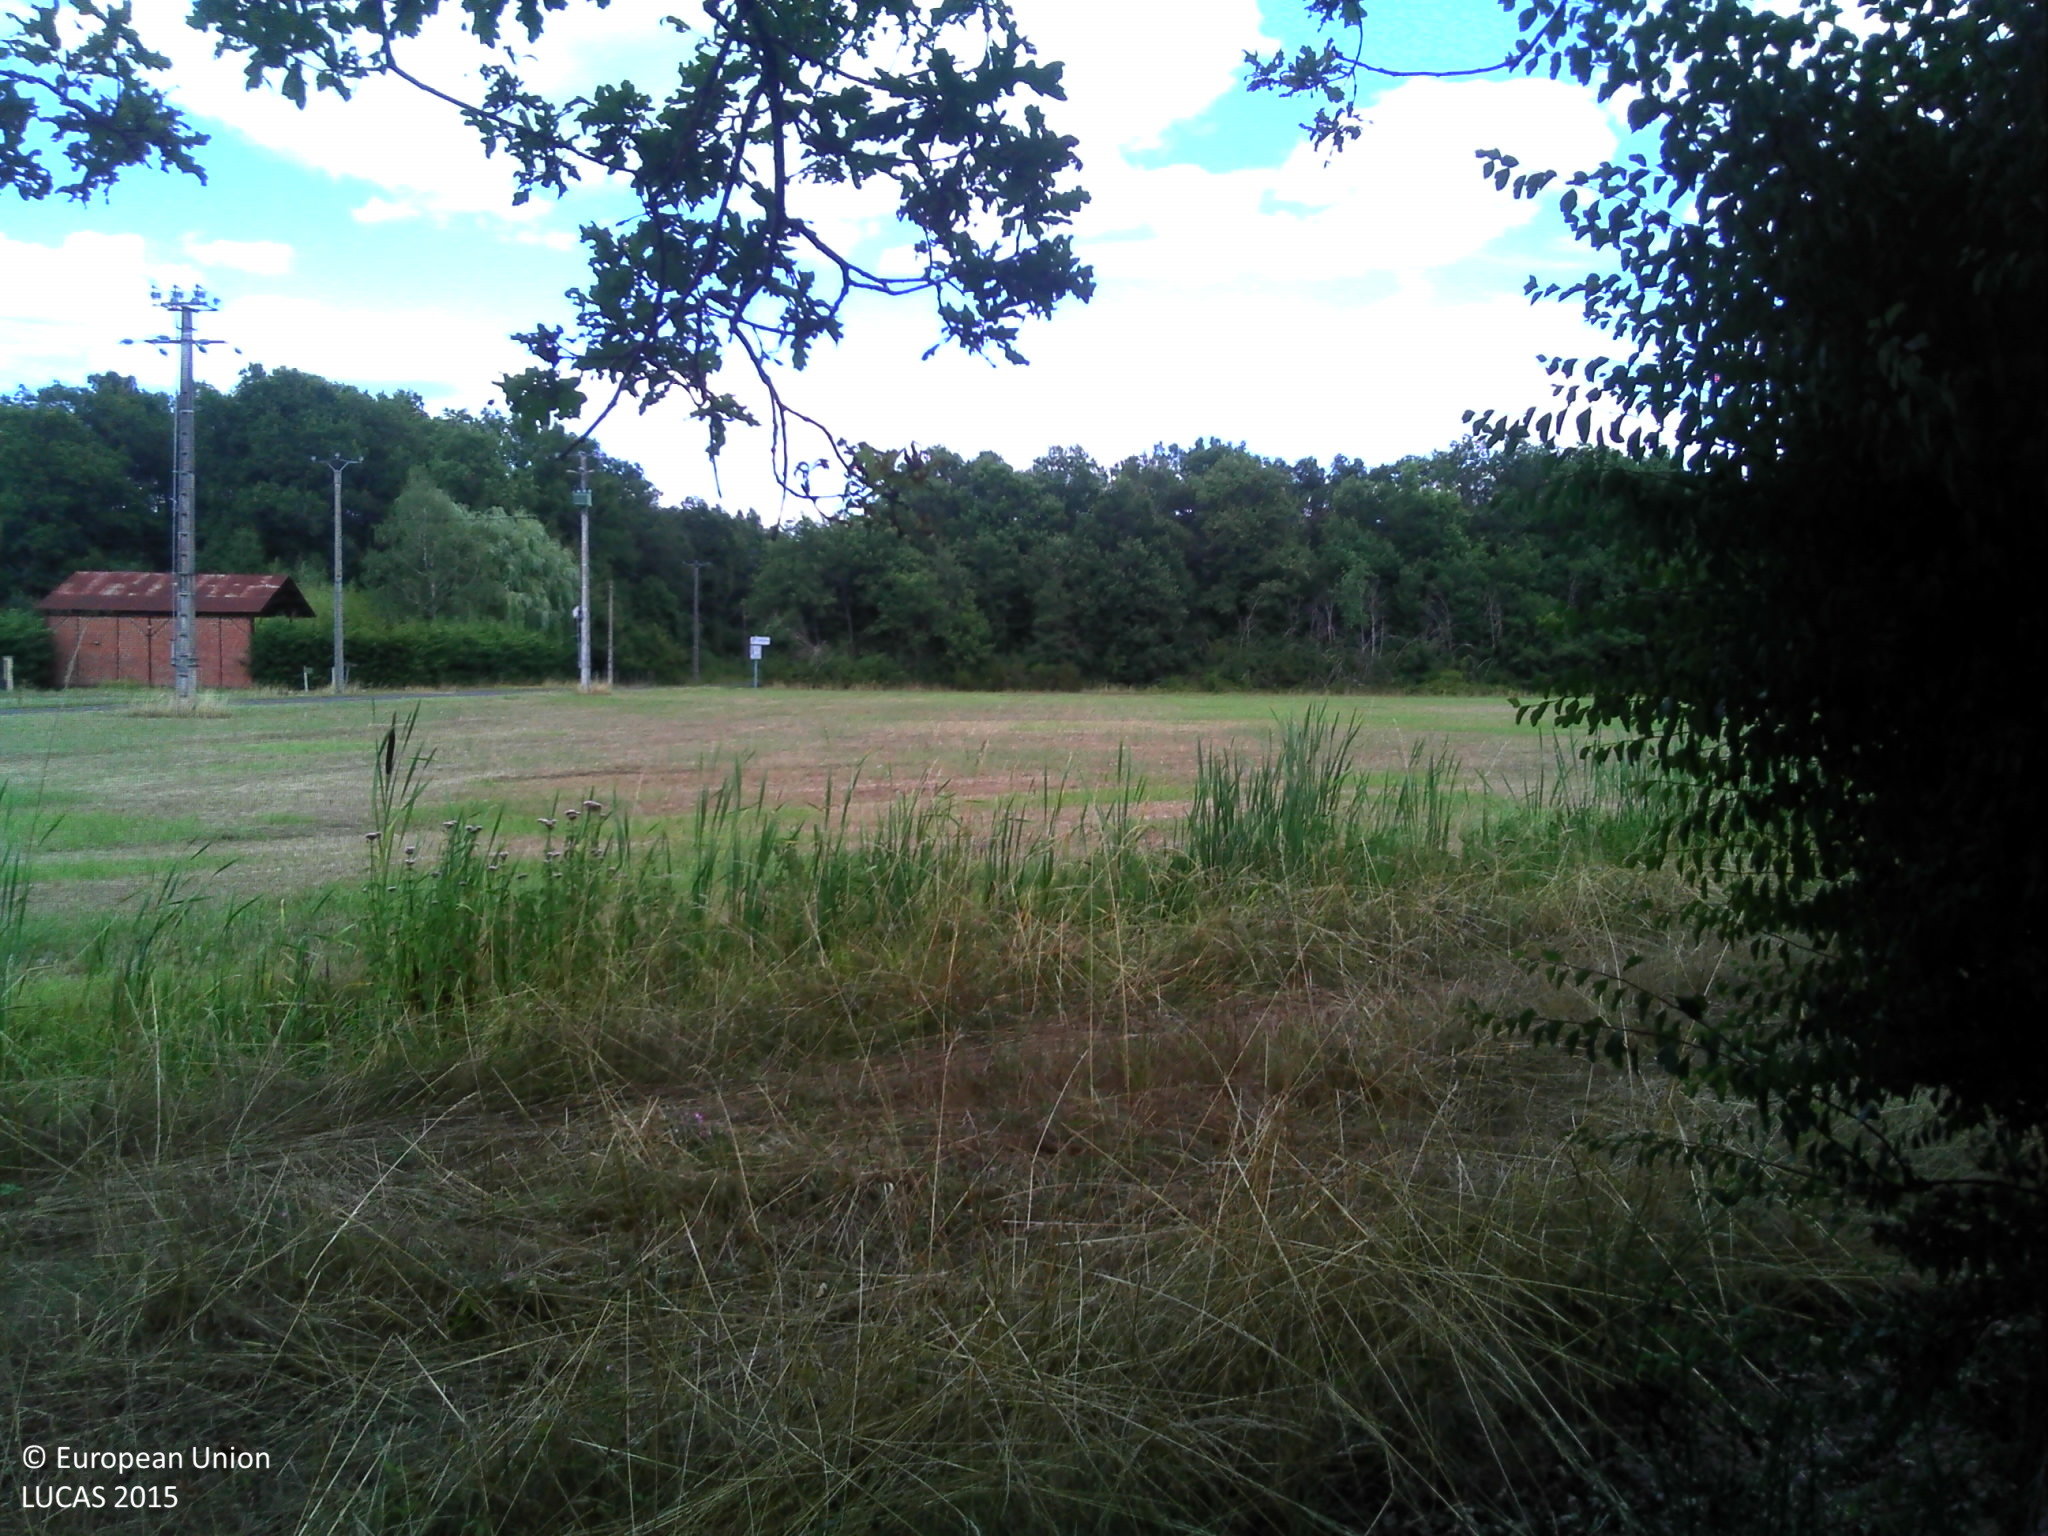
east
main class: Grassland
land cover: Grassland with sparse tree/shrub cover
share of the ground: > 75 %
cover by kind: herbaceous plants 95 %, broadleaved forest trees 5 %
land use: Residential
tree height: > 5 m
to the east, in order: Grassland with sparse tree/shrub cover; Fences; Managed hedges; Grass margins; Tracks; Grass margins; Ditches and canals; Grassland without tree/shrub cover; Broadleaved woodland; Grassland without tree/shrub cover
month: July
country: FR
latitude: 47.9556
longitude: 2.5858
